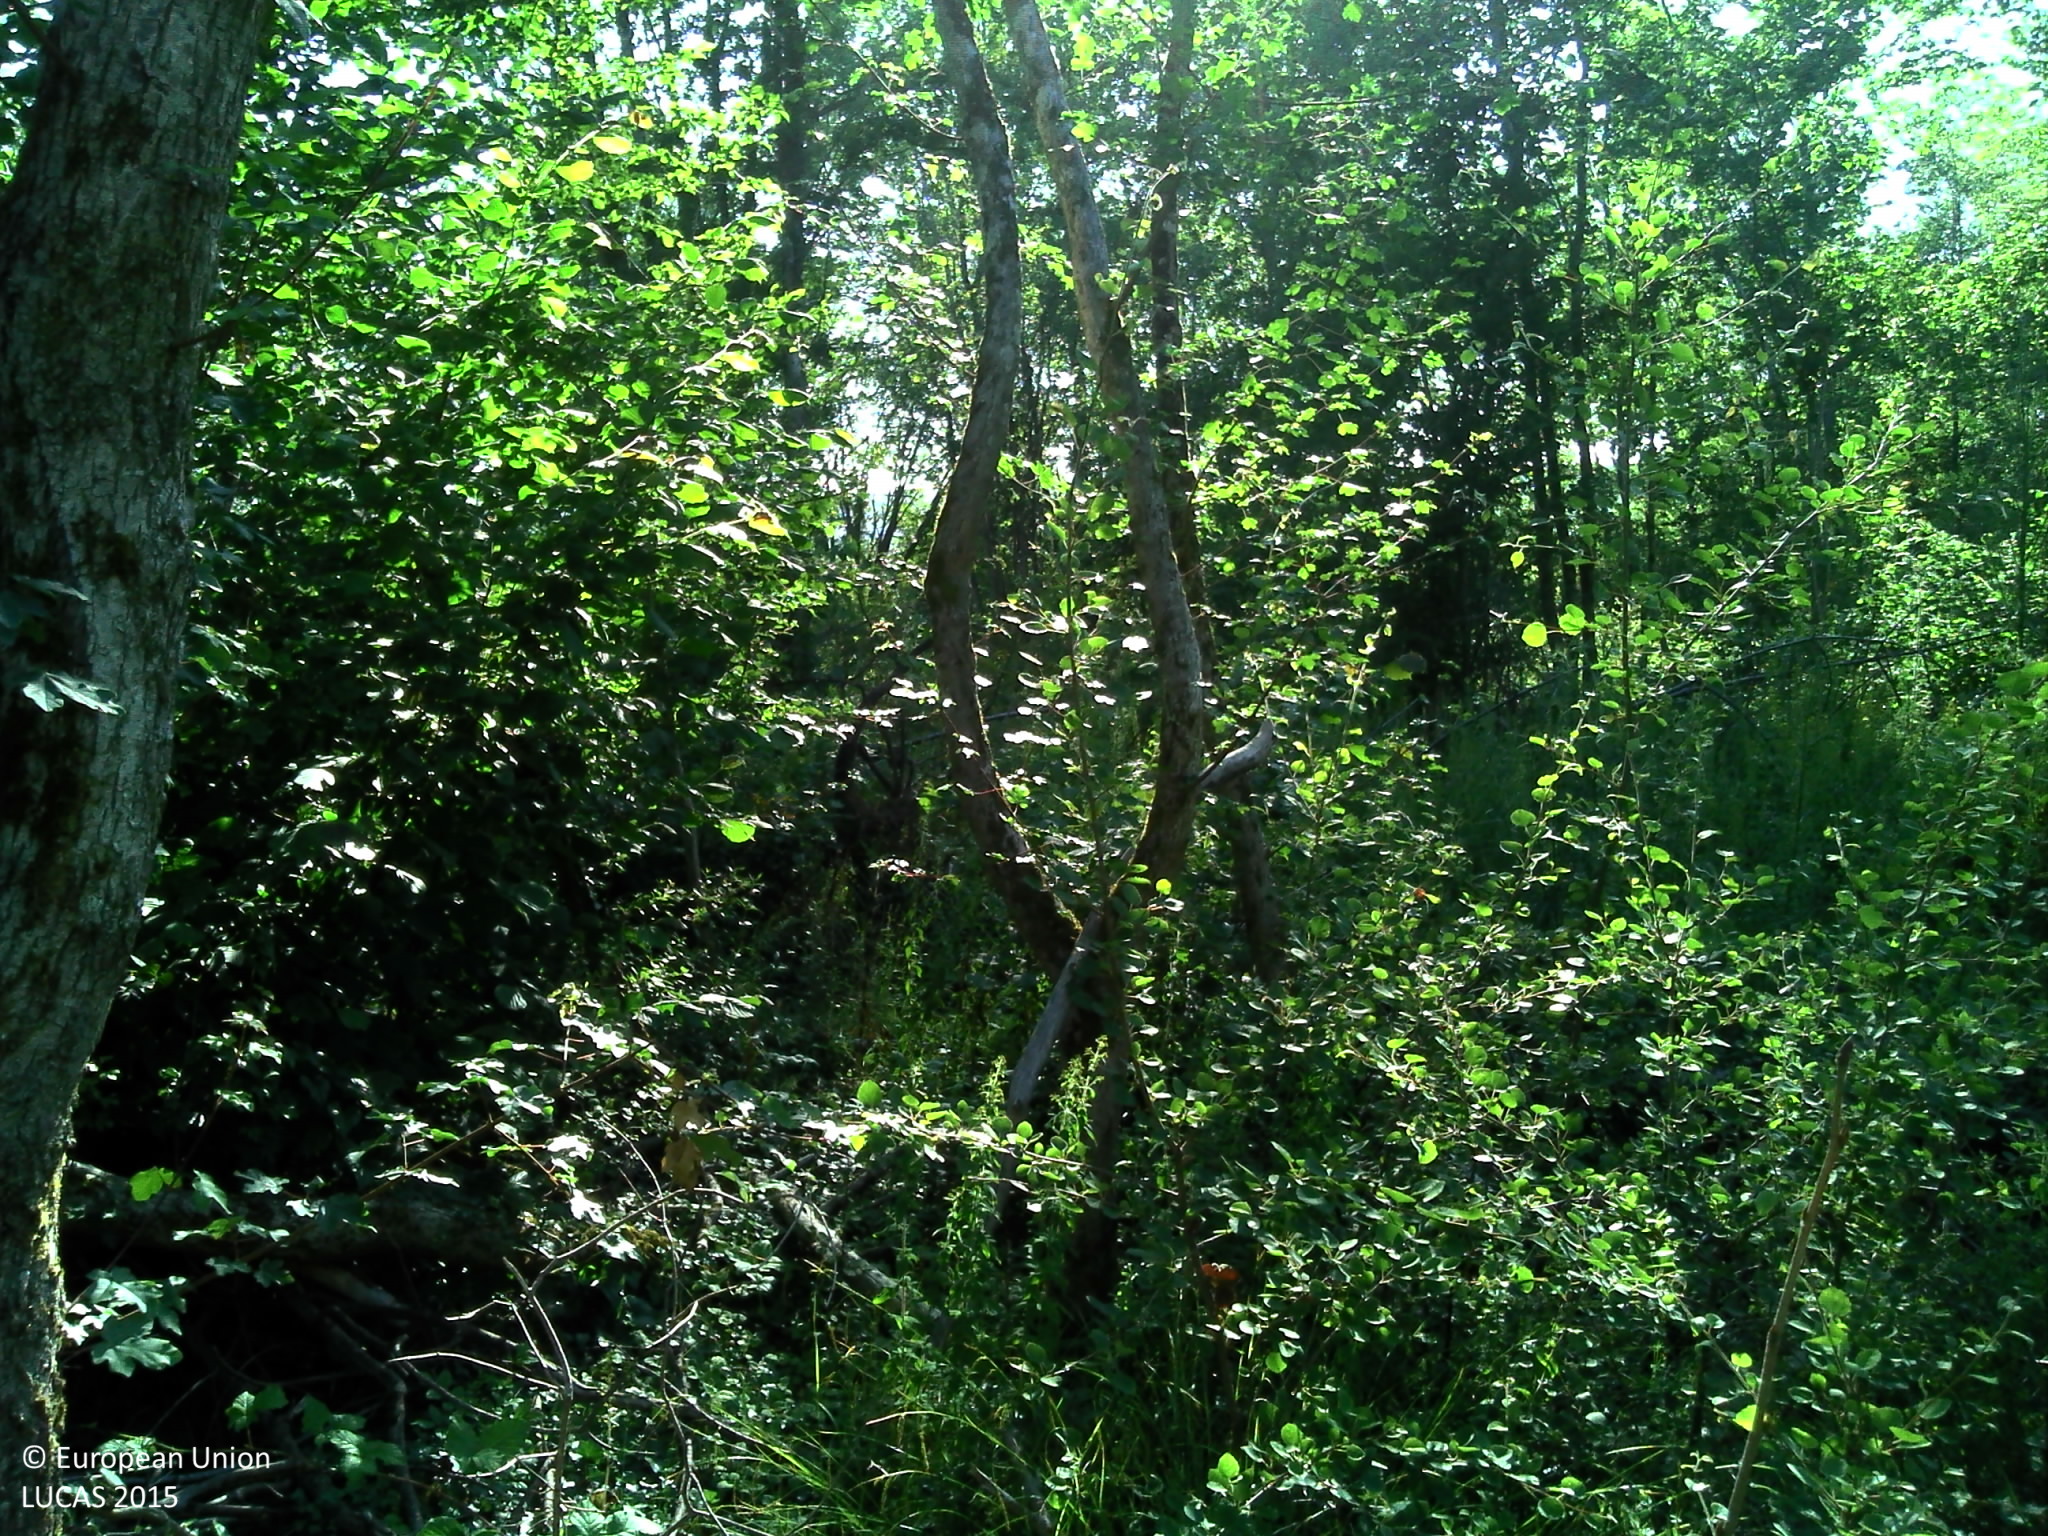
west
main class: Woodland
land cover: Broadleaved woodland
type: acidophilous oak and oak-birch forest
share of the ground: > 75 %
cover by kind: broadleaved forest trees 95 %, lichens and mosses 5 %
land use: Forestry
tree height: > 5 m
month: June
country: FR
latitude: 48.5452
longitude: 0.1785
